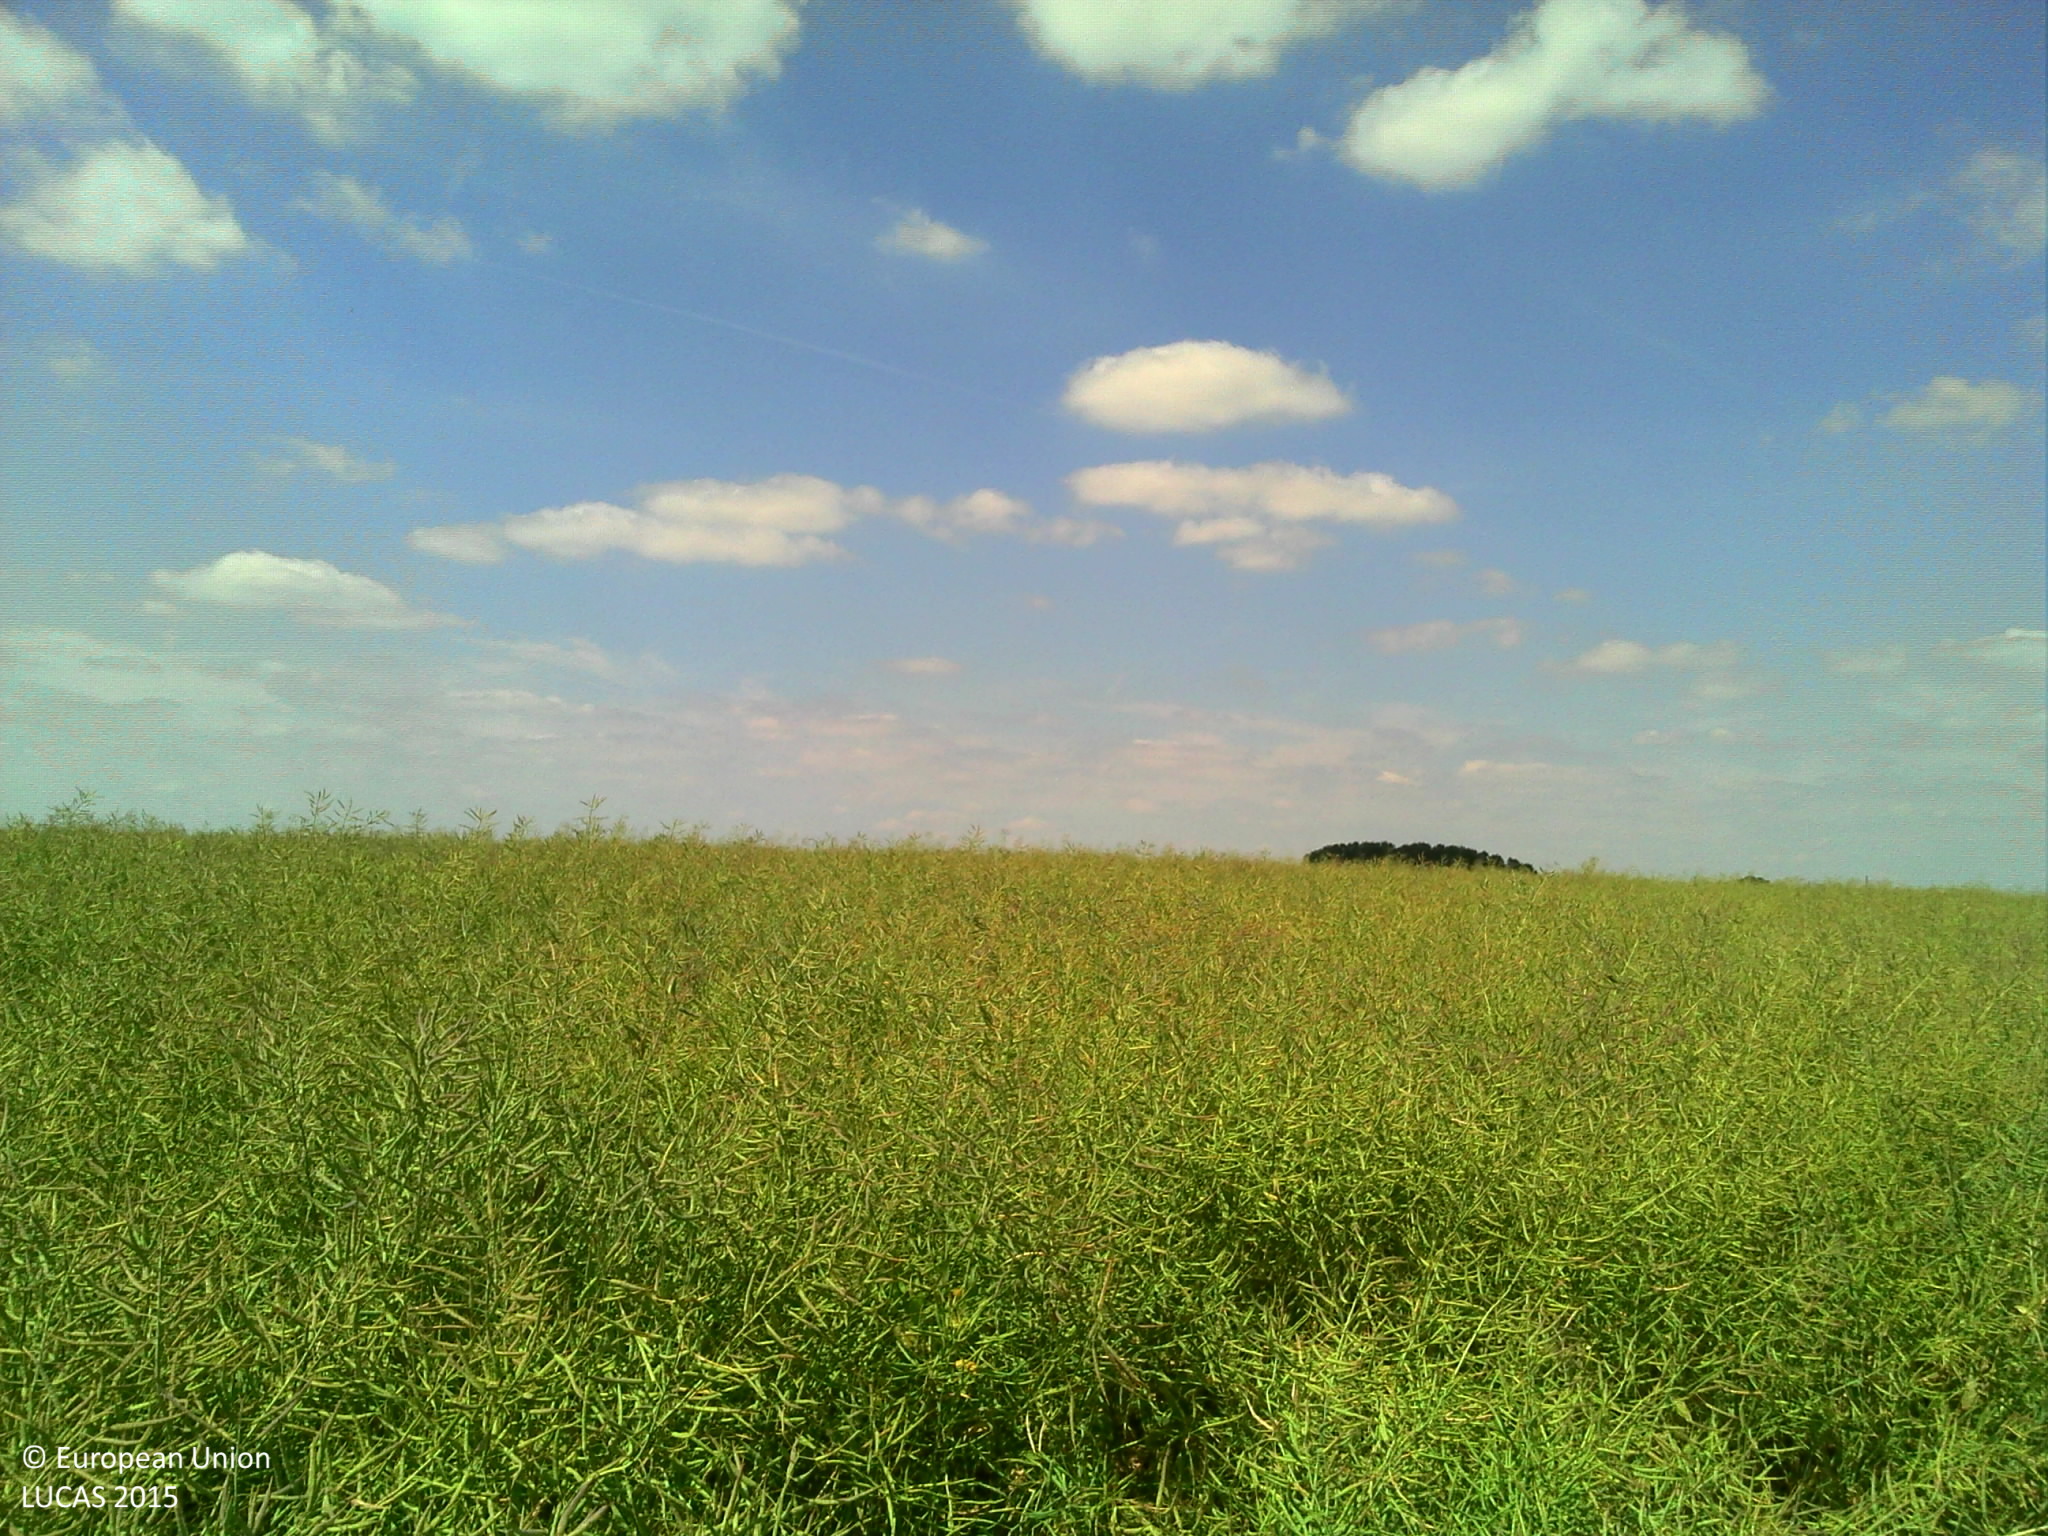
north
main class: Cropland
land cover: Rape and turnip rape
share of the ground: > 75 %
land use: Agriculture (excluding fallow land and kitchen gardens)
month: June
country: FR
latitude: 49.6531
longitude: 2.8563
